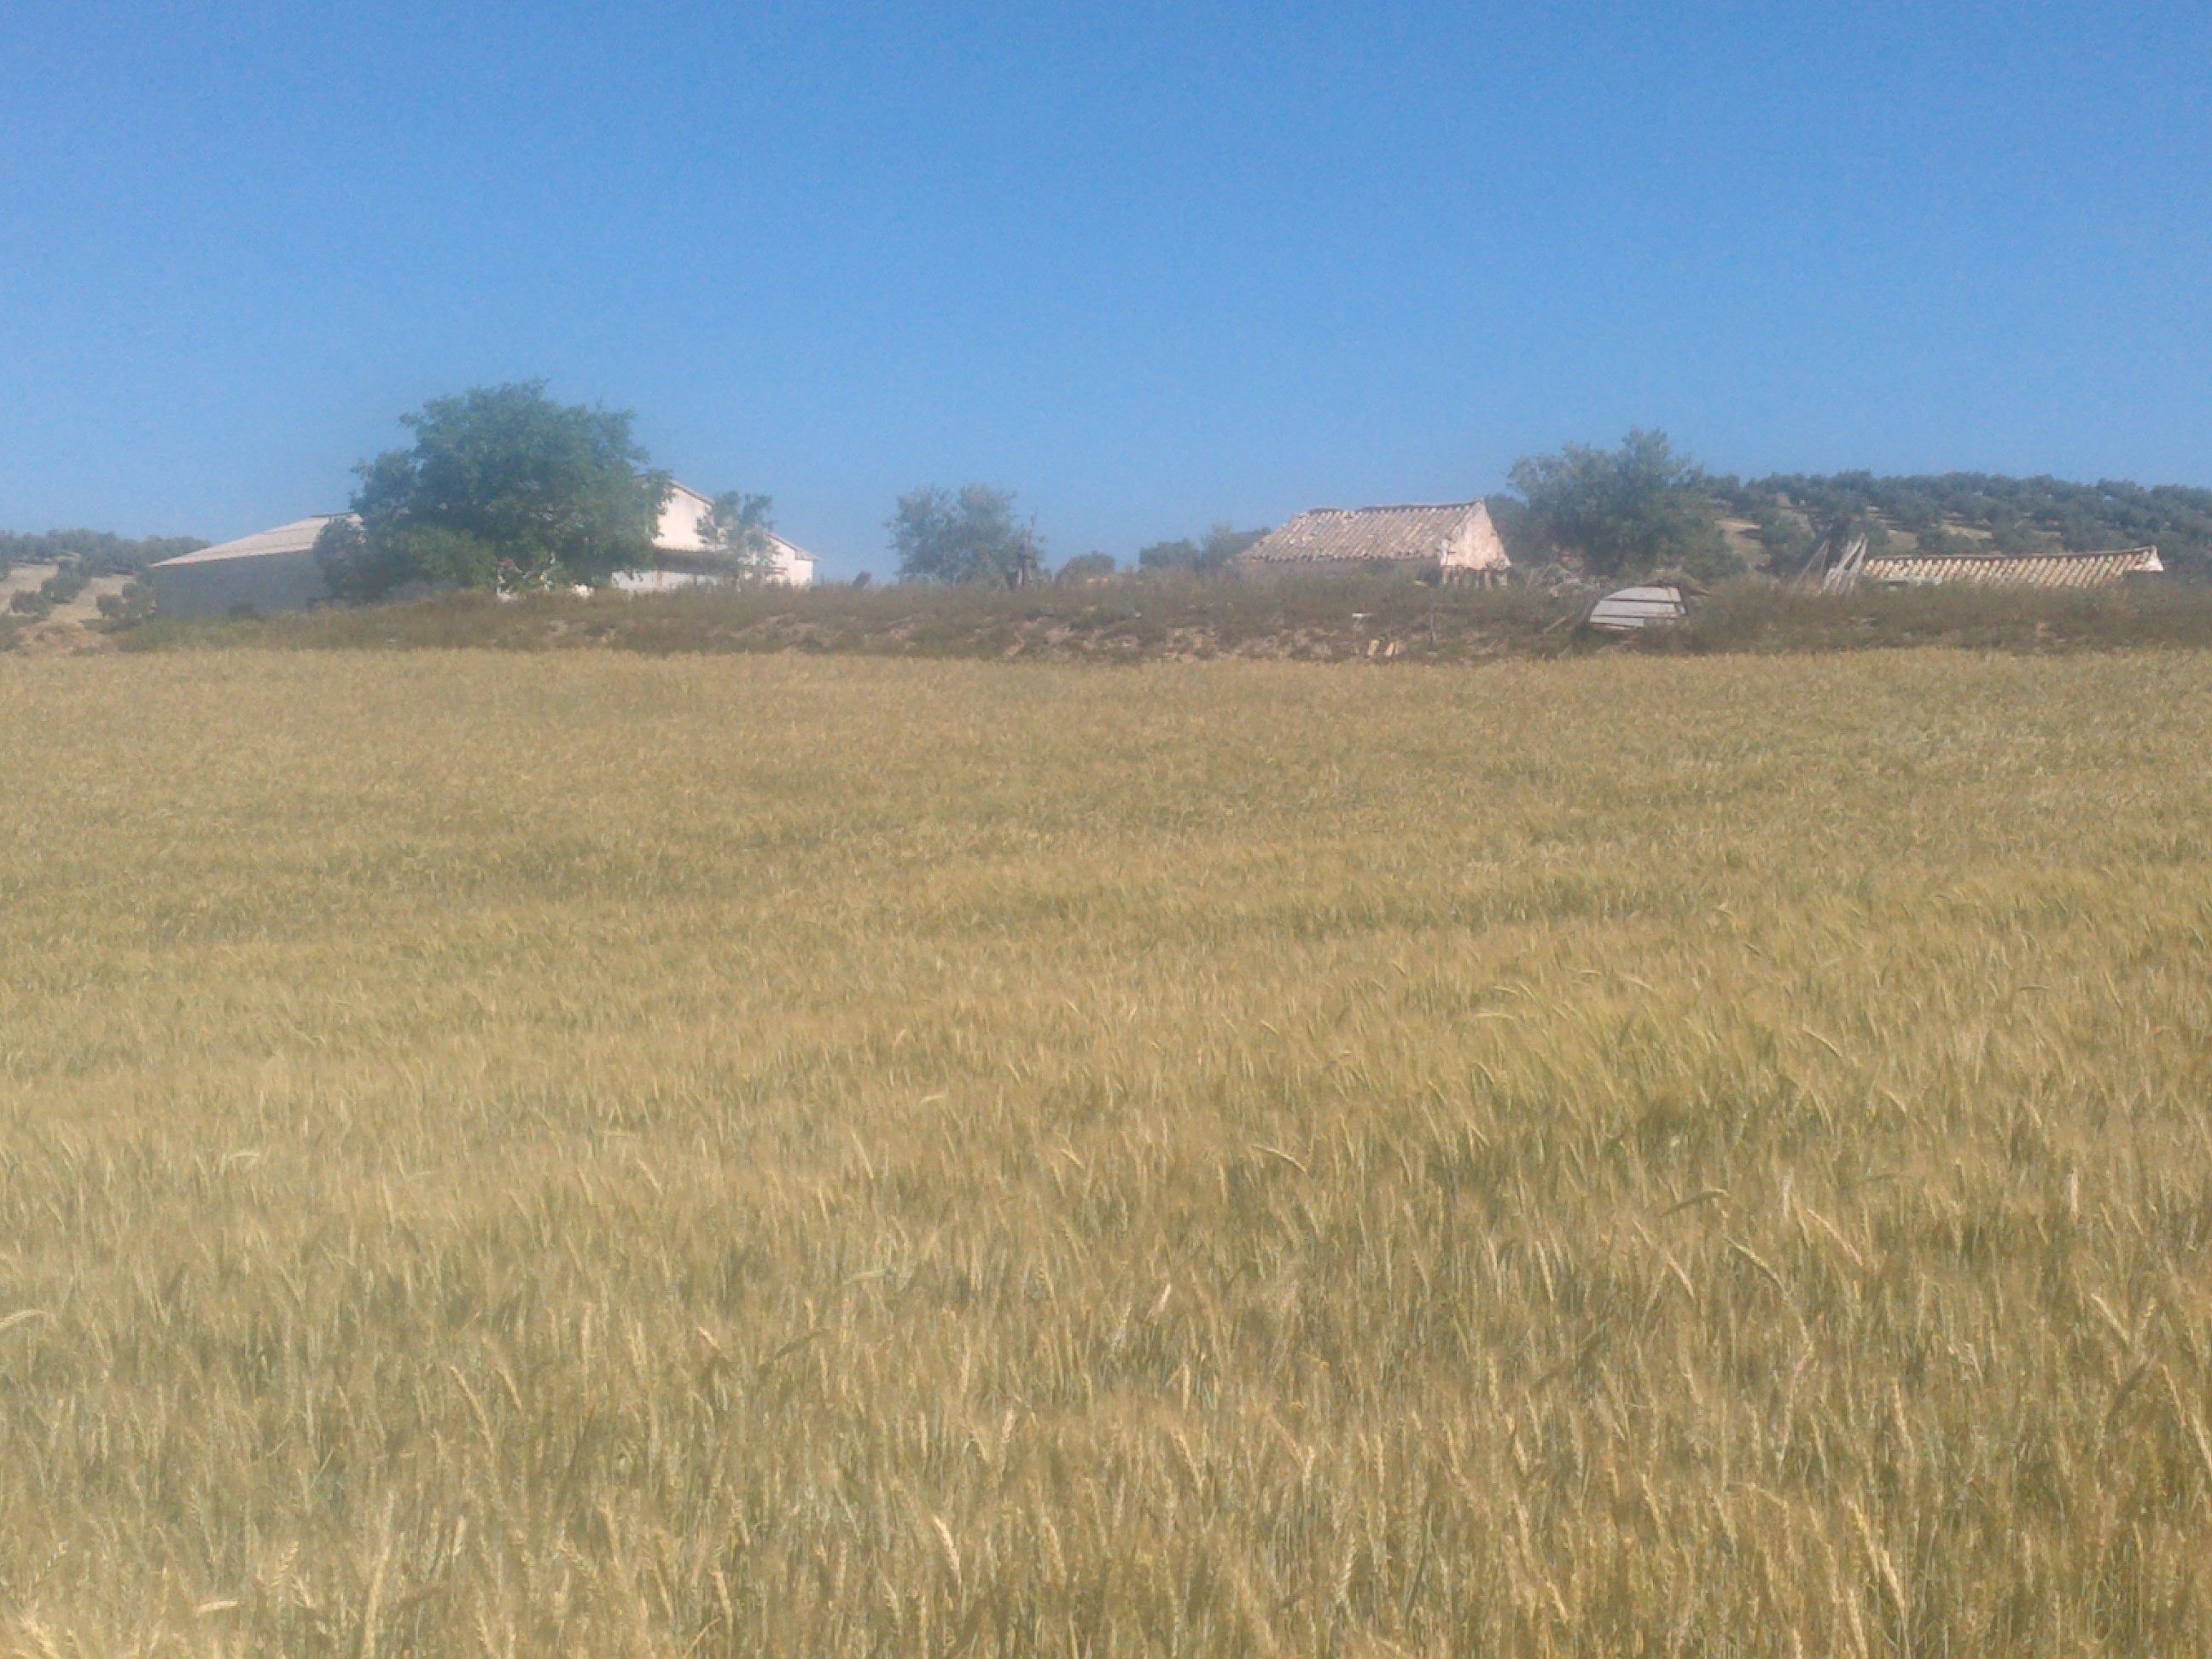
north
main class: Cropland
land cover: Durum wheat
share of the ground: > 75 %
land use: Agriculture (excluding fallow land and kitchen gardens)
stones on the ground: < 10 %
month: May
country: ES
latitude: 37.7229
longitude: -4.5650
